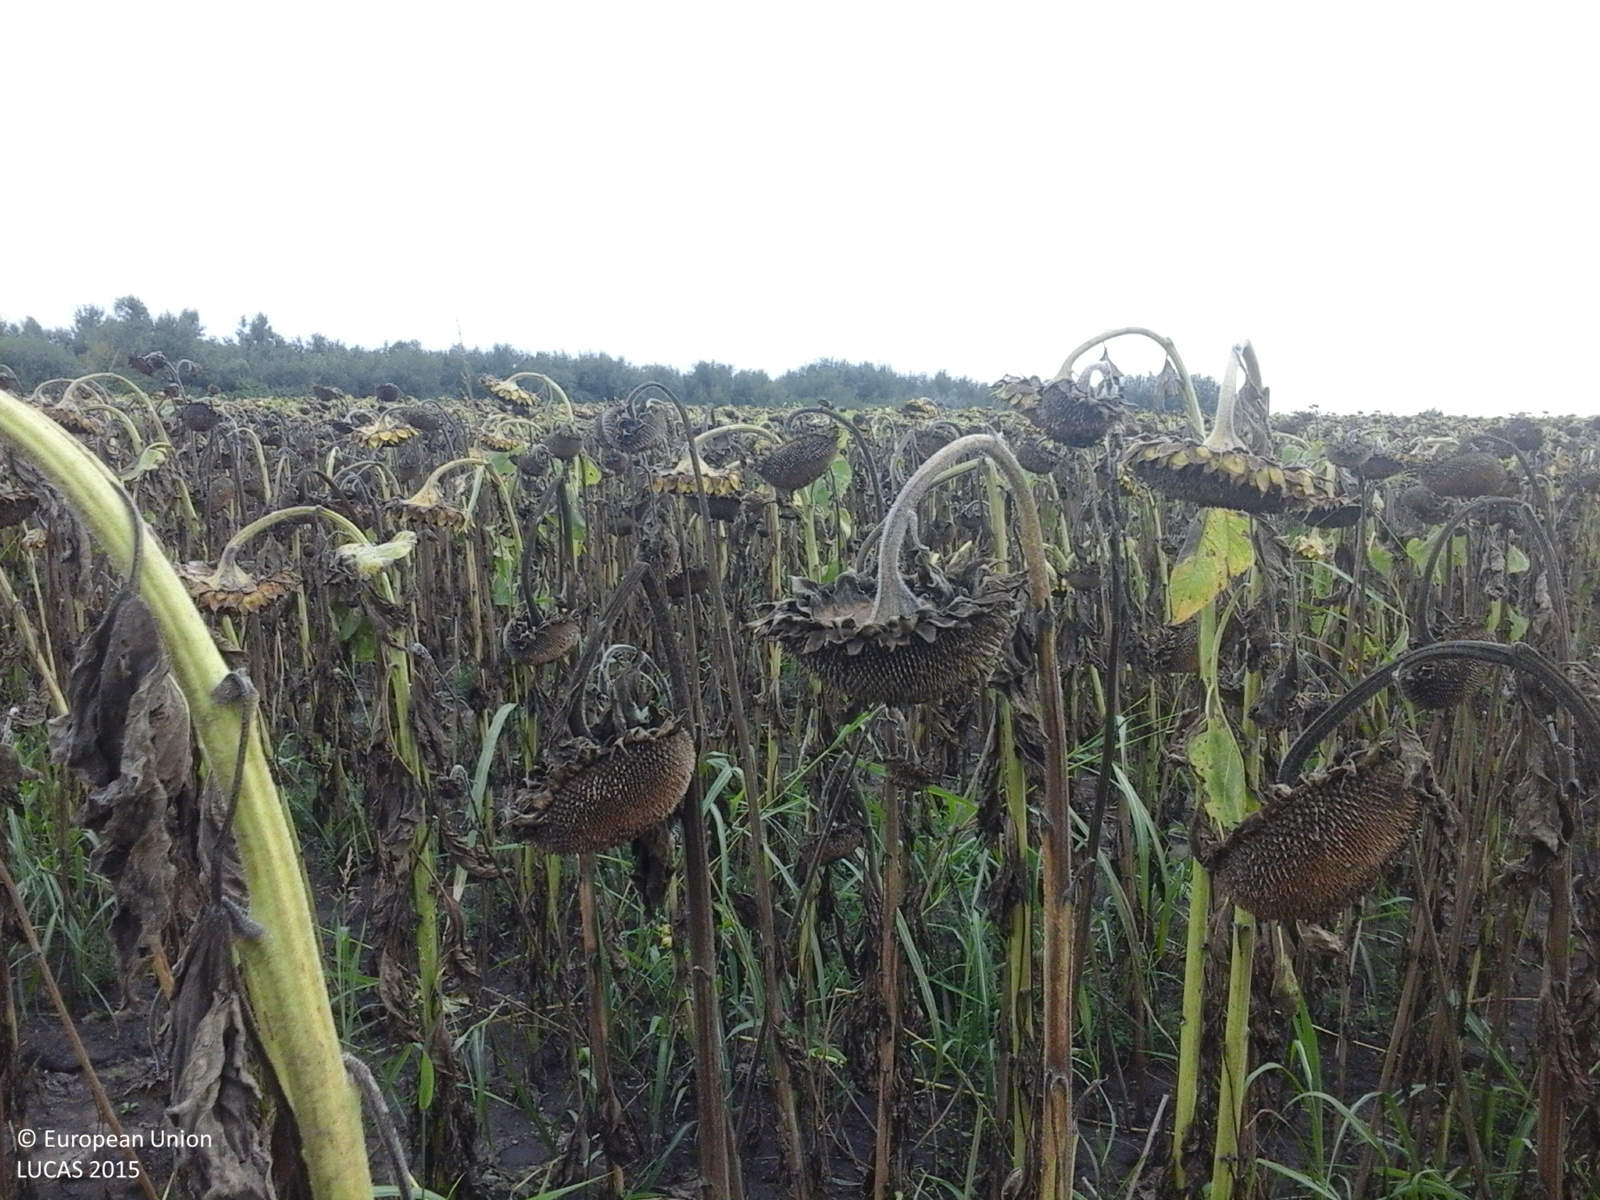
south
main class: Cropland
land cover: Sunflower
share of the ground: > 75 %
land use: Agriculture (excluding fallow land and kitchen gardens)
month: August
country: RO
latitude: 46.2872
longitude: 21.2087
